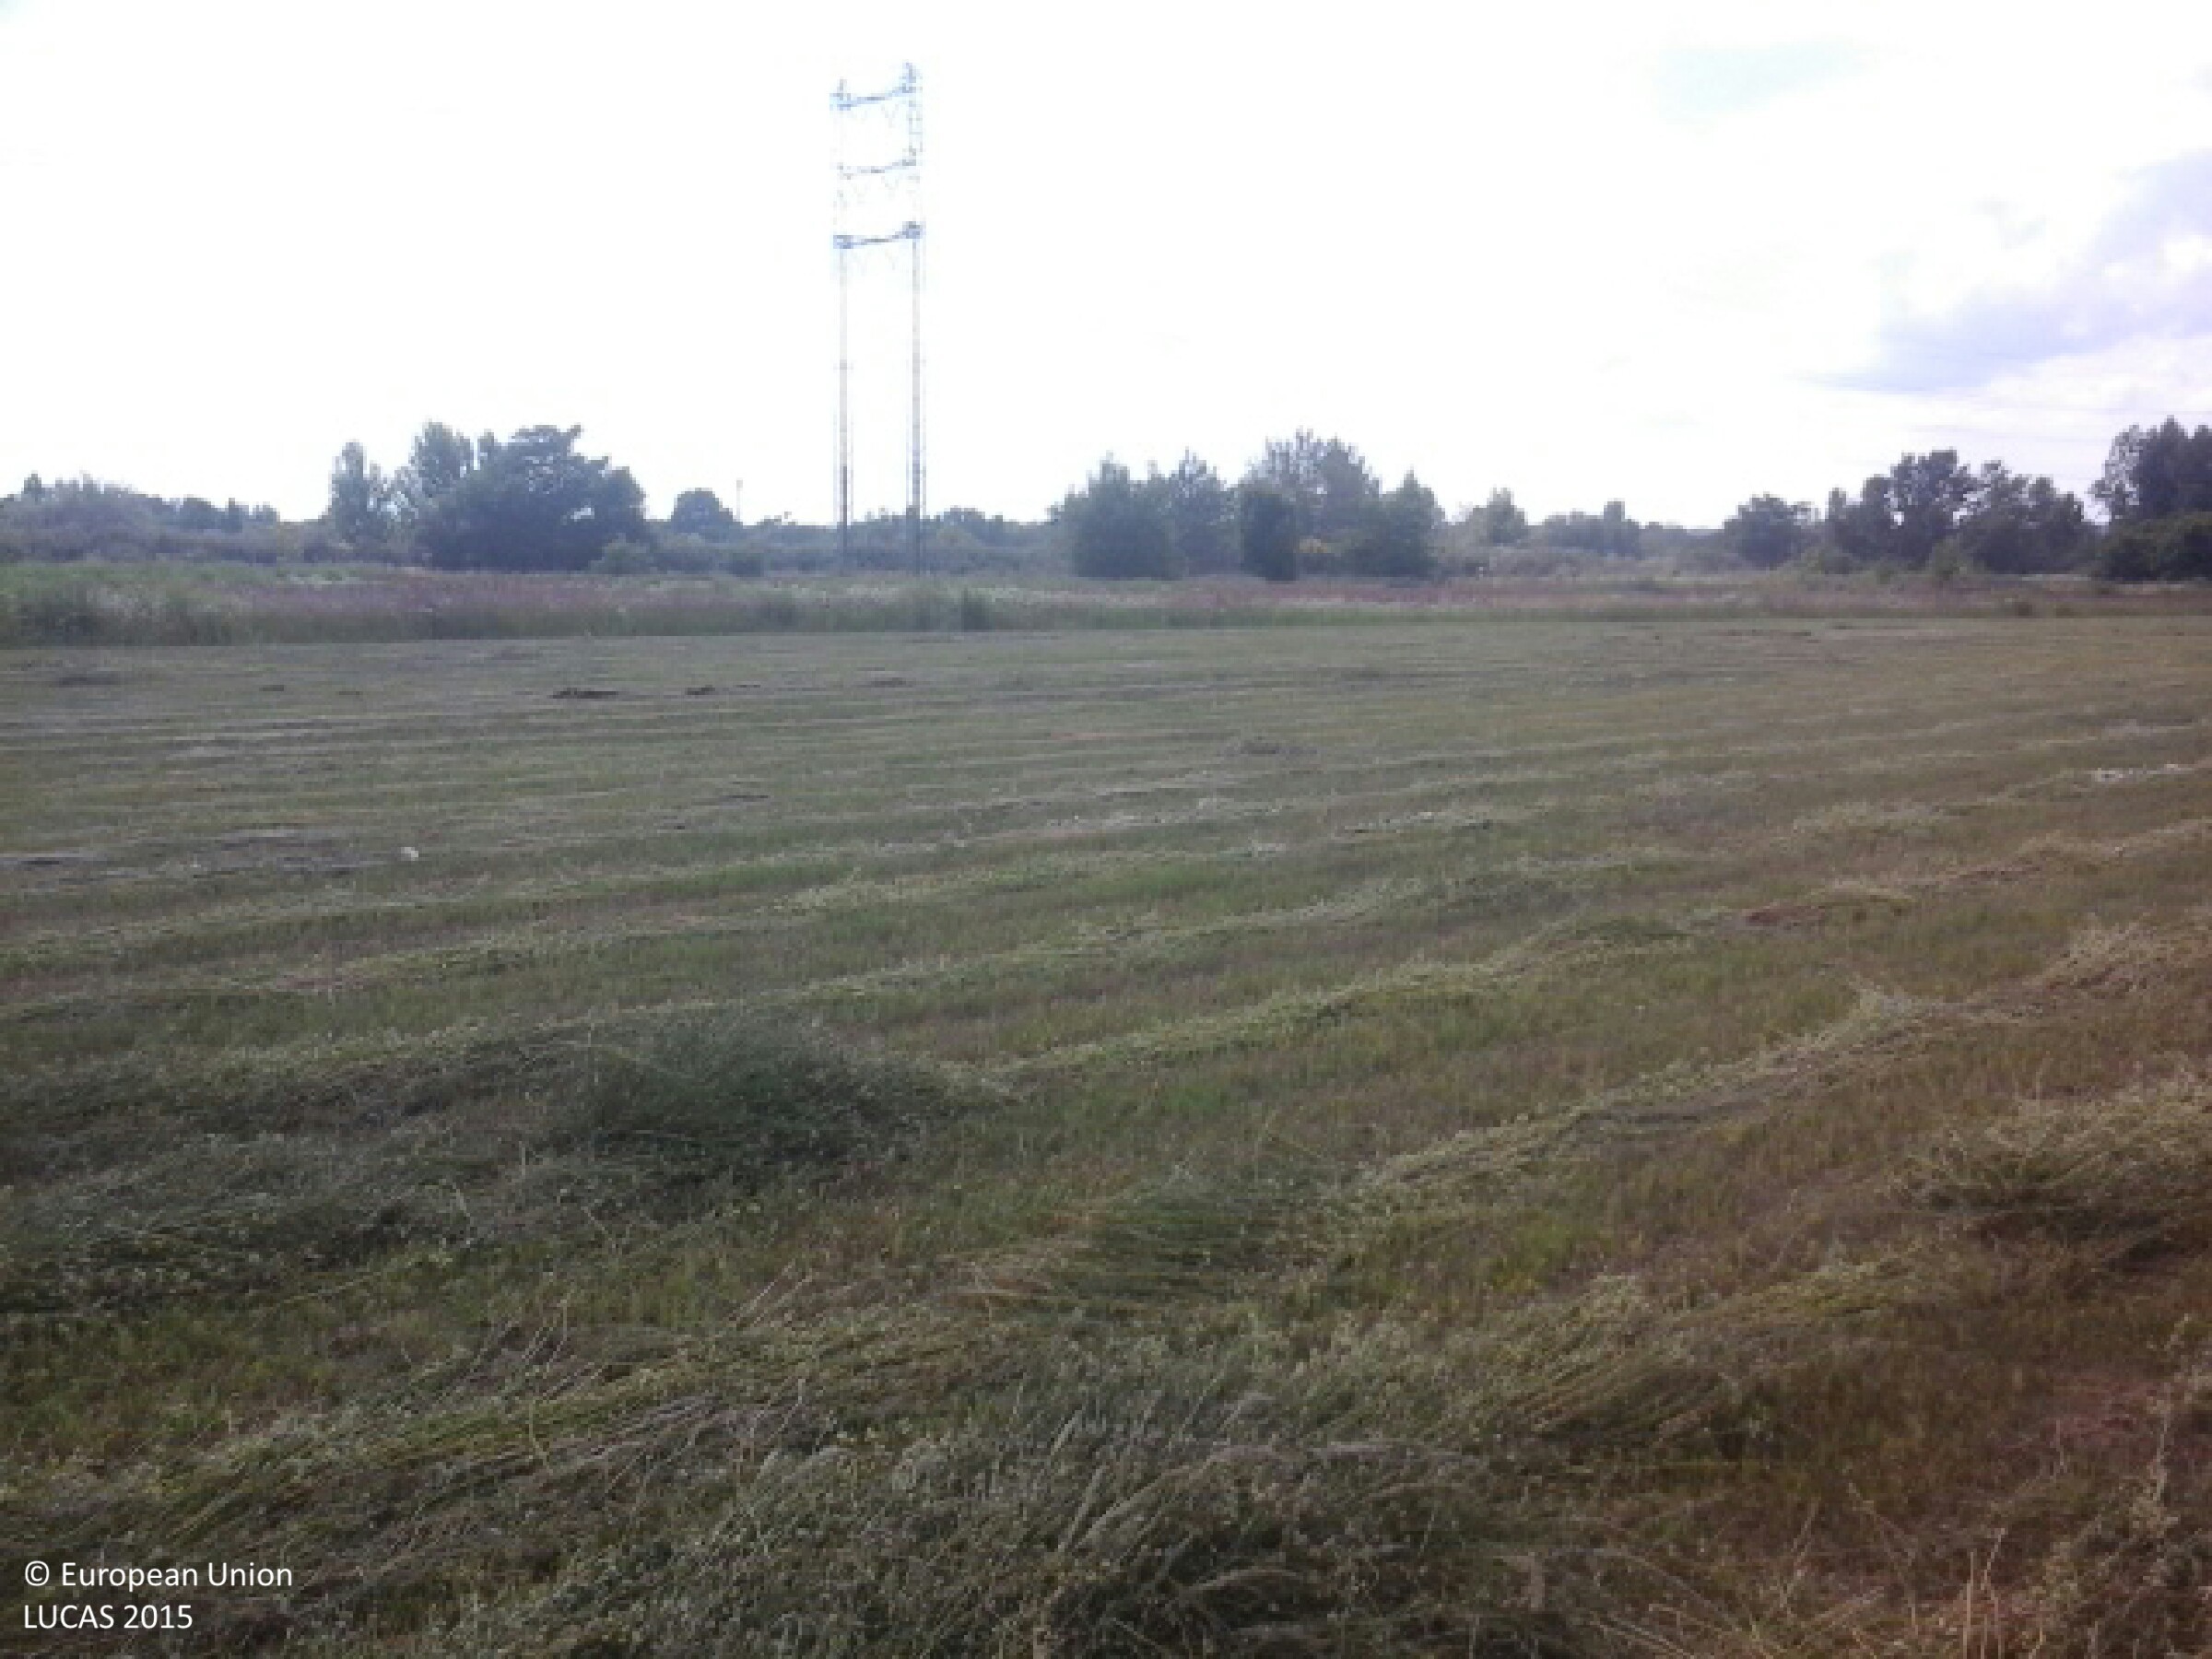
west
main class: Grassland
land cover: Grassland without tree/shrub cover
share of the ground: > 75 %
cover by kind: herbaceous plants 100 %
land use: Agriculture (excluding fallow land and kitchen gardens)
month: June
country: HU
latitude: 47.3966
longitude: 19.0668
